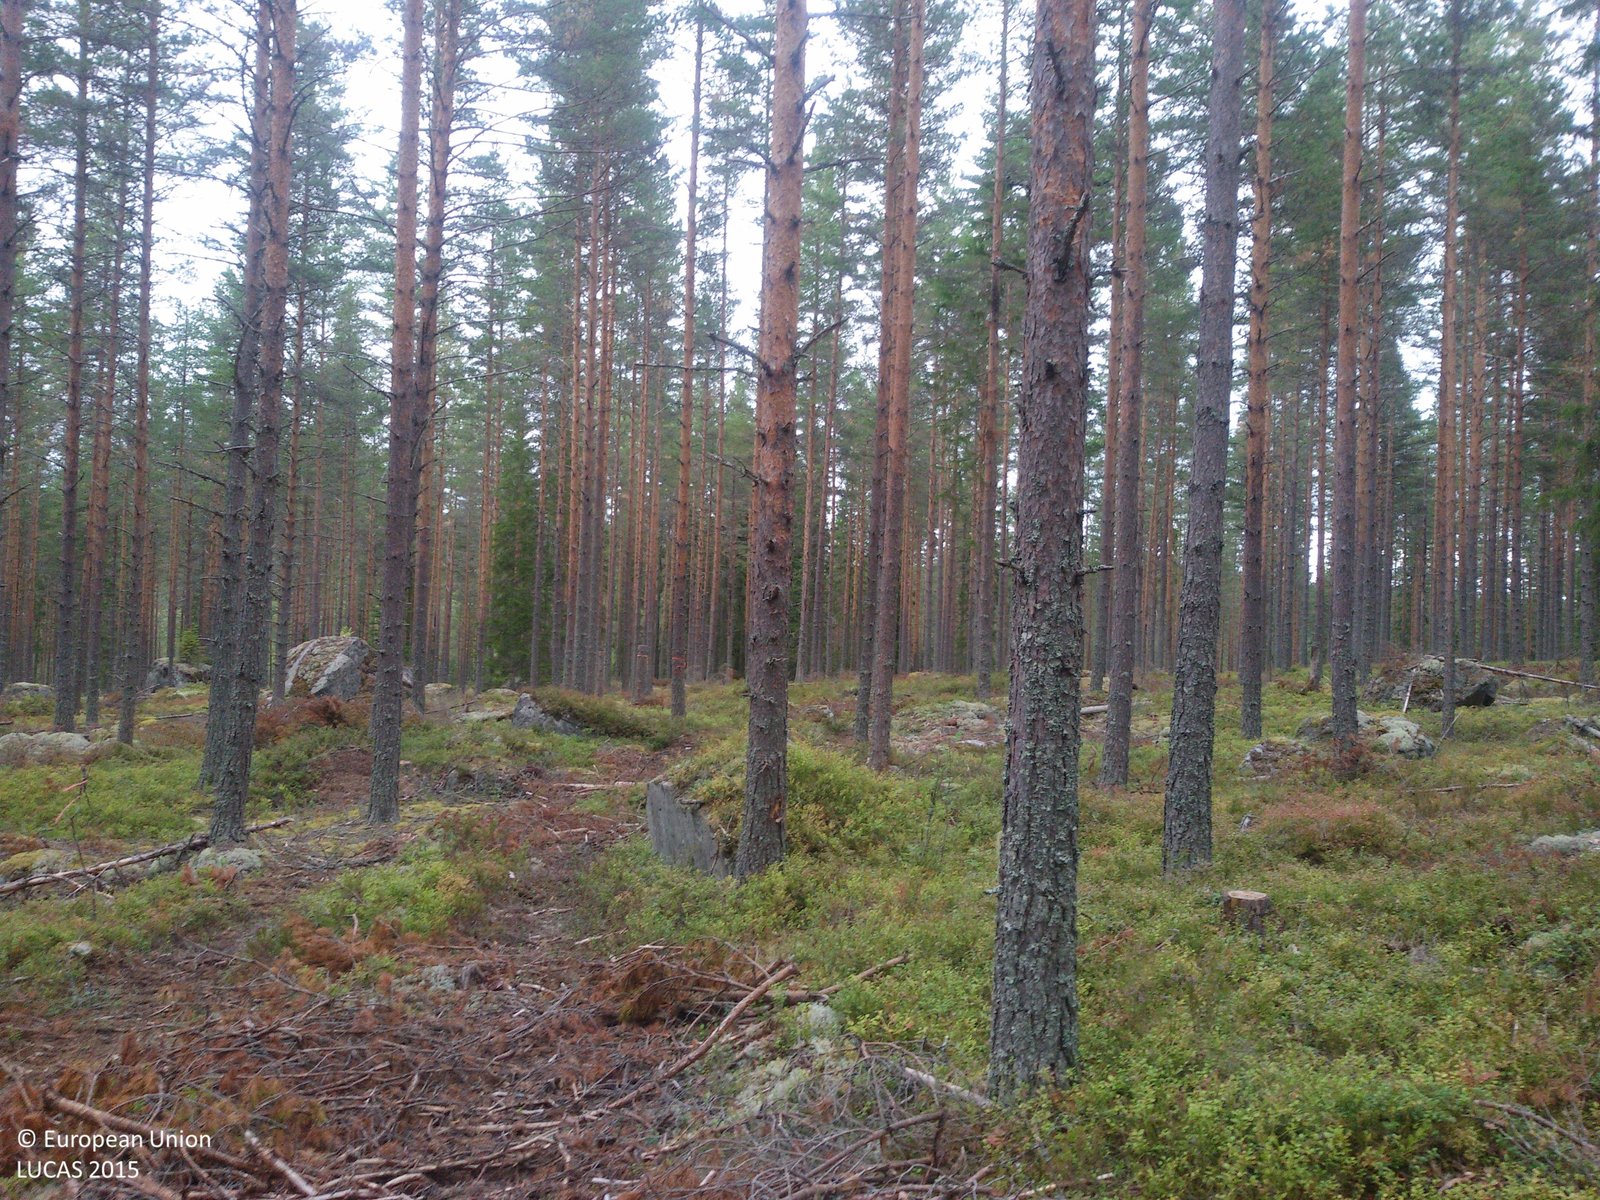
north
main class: Woodland
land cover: Pine dominated coniferous woodland
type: boreal forest
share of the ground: 50 - 75 %
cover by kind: coniferous forest trees 50 %, herbaceous plants 25 %, lichens and mosses 15 %, shrubs 10 %
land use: Forestry
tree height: > 5 m
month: September
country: SE
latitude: 60.7713
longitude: 15.6597
